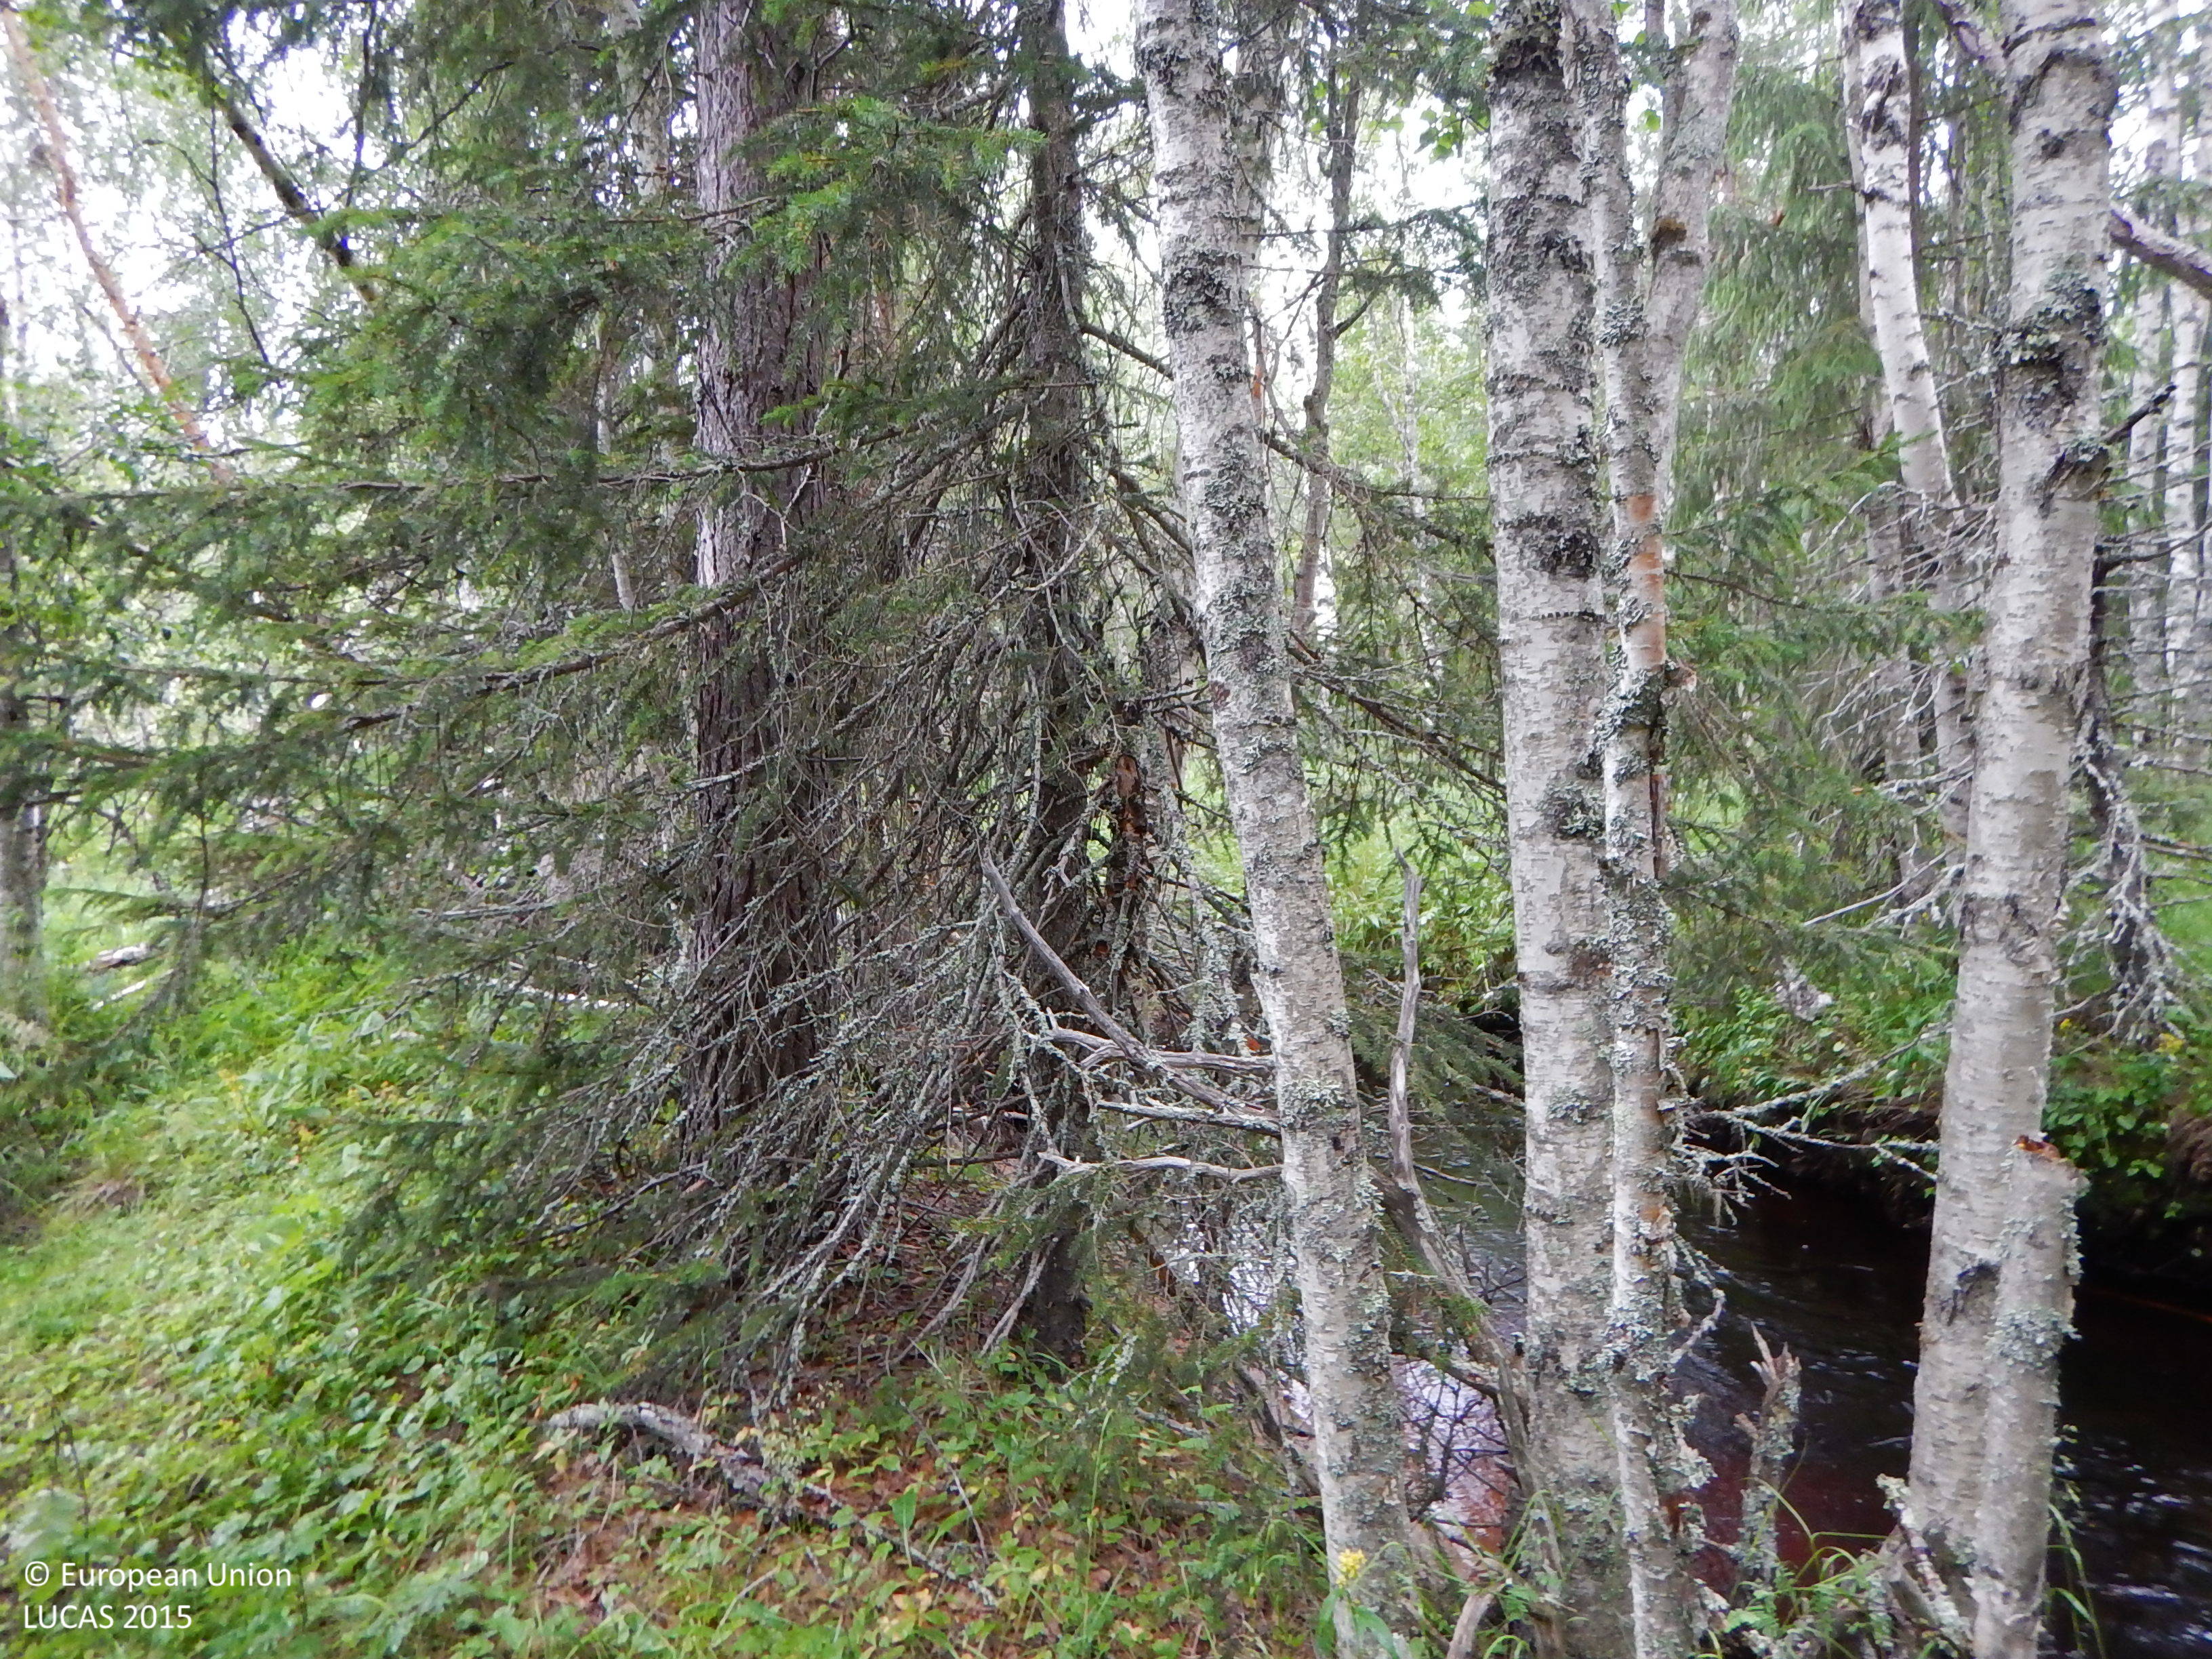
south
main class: Woodland
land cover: Other mixed woodland
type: boreal forest
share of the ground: 50 - 75 %
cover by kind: broadleaved forest trees 40 %, herbaceous plants 20 %, coniferous forest trees 15 %, lichens and mosses 15 %, shrubs 10 %
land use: Forestry
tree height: > 5 m
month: July
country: SE
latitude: 64.9853
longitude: 20.4210
